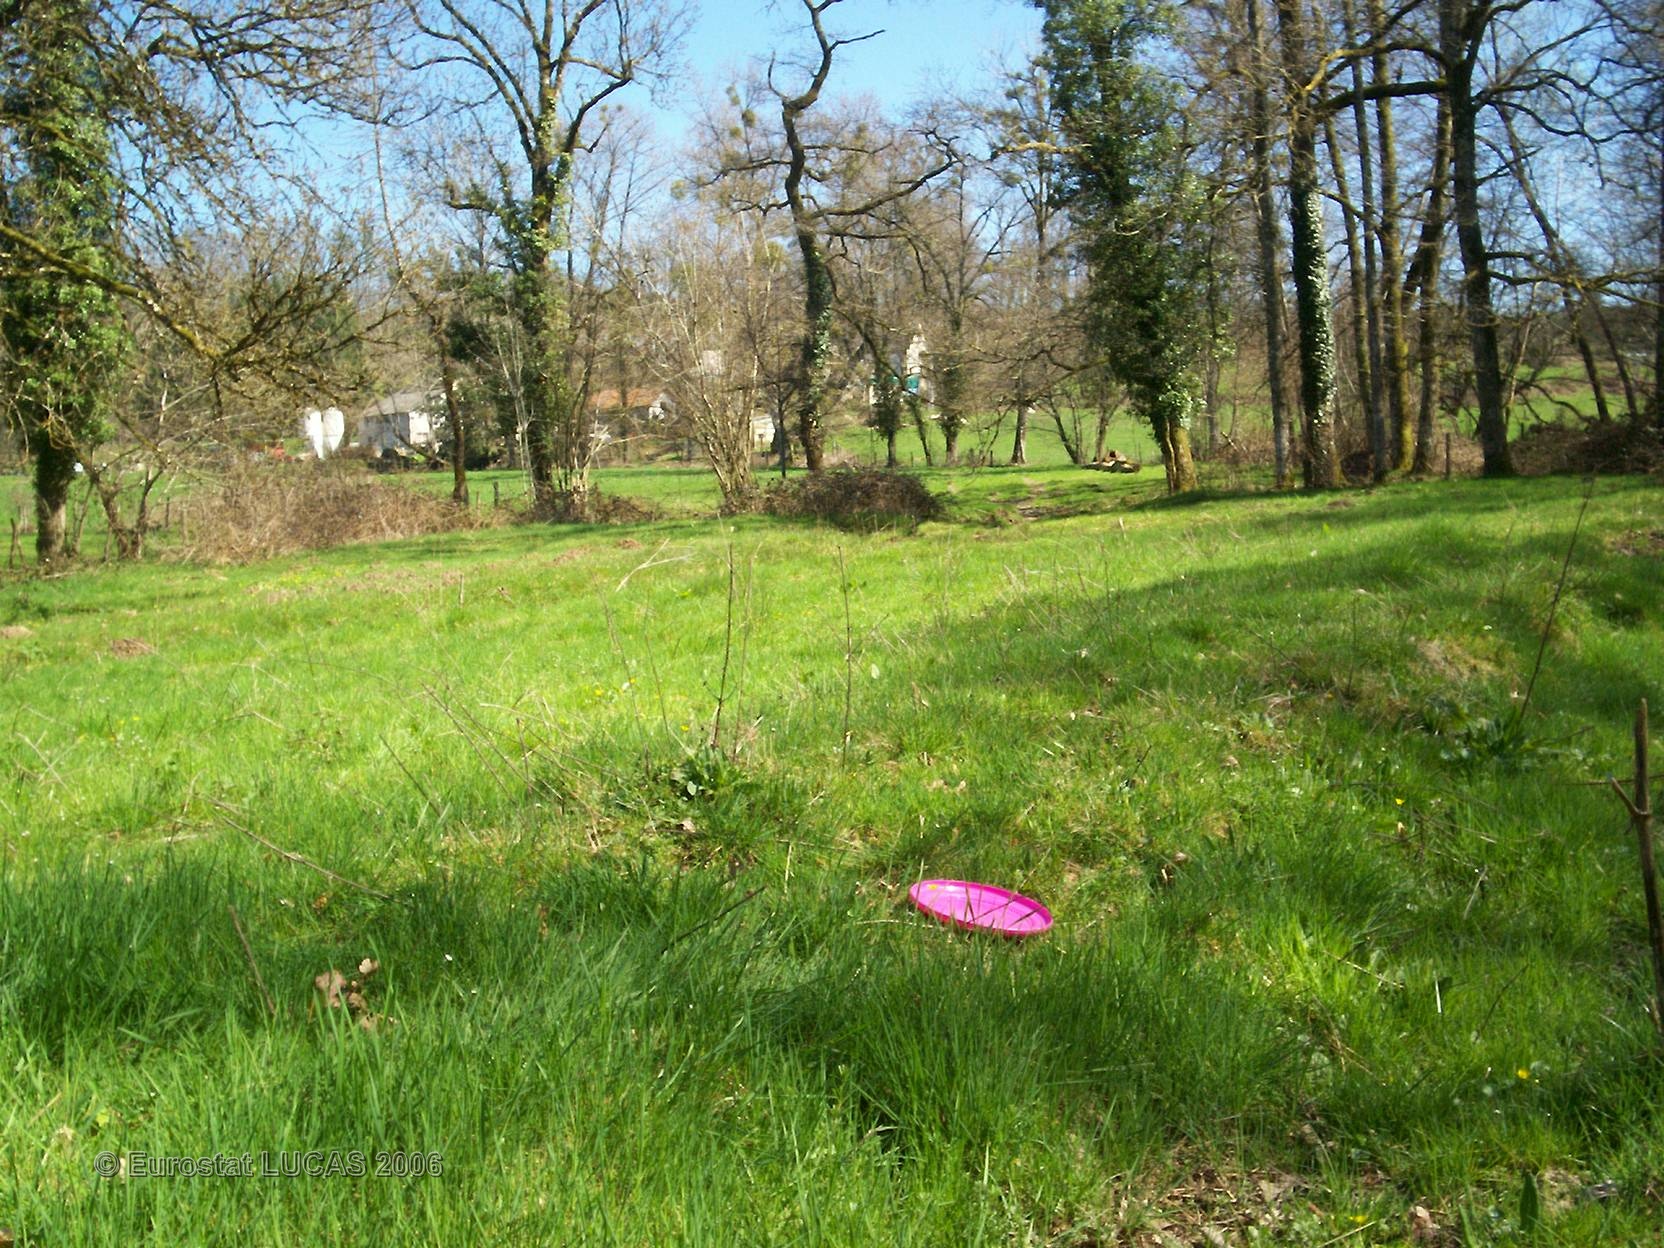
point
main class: Grassland
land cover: Grassland with sparse tree/shrub cover
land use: Unused
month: April
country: FR
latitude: 45.2994
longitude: 1.6424
